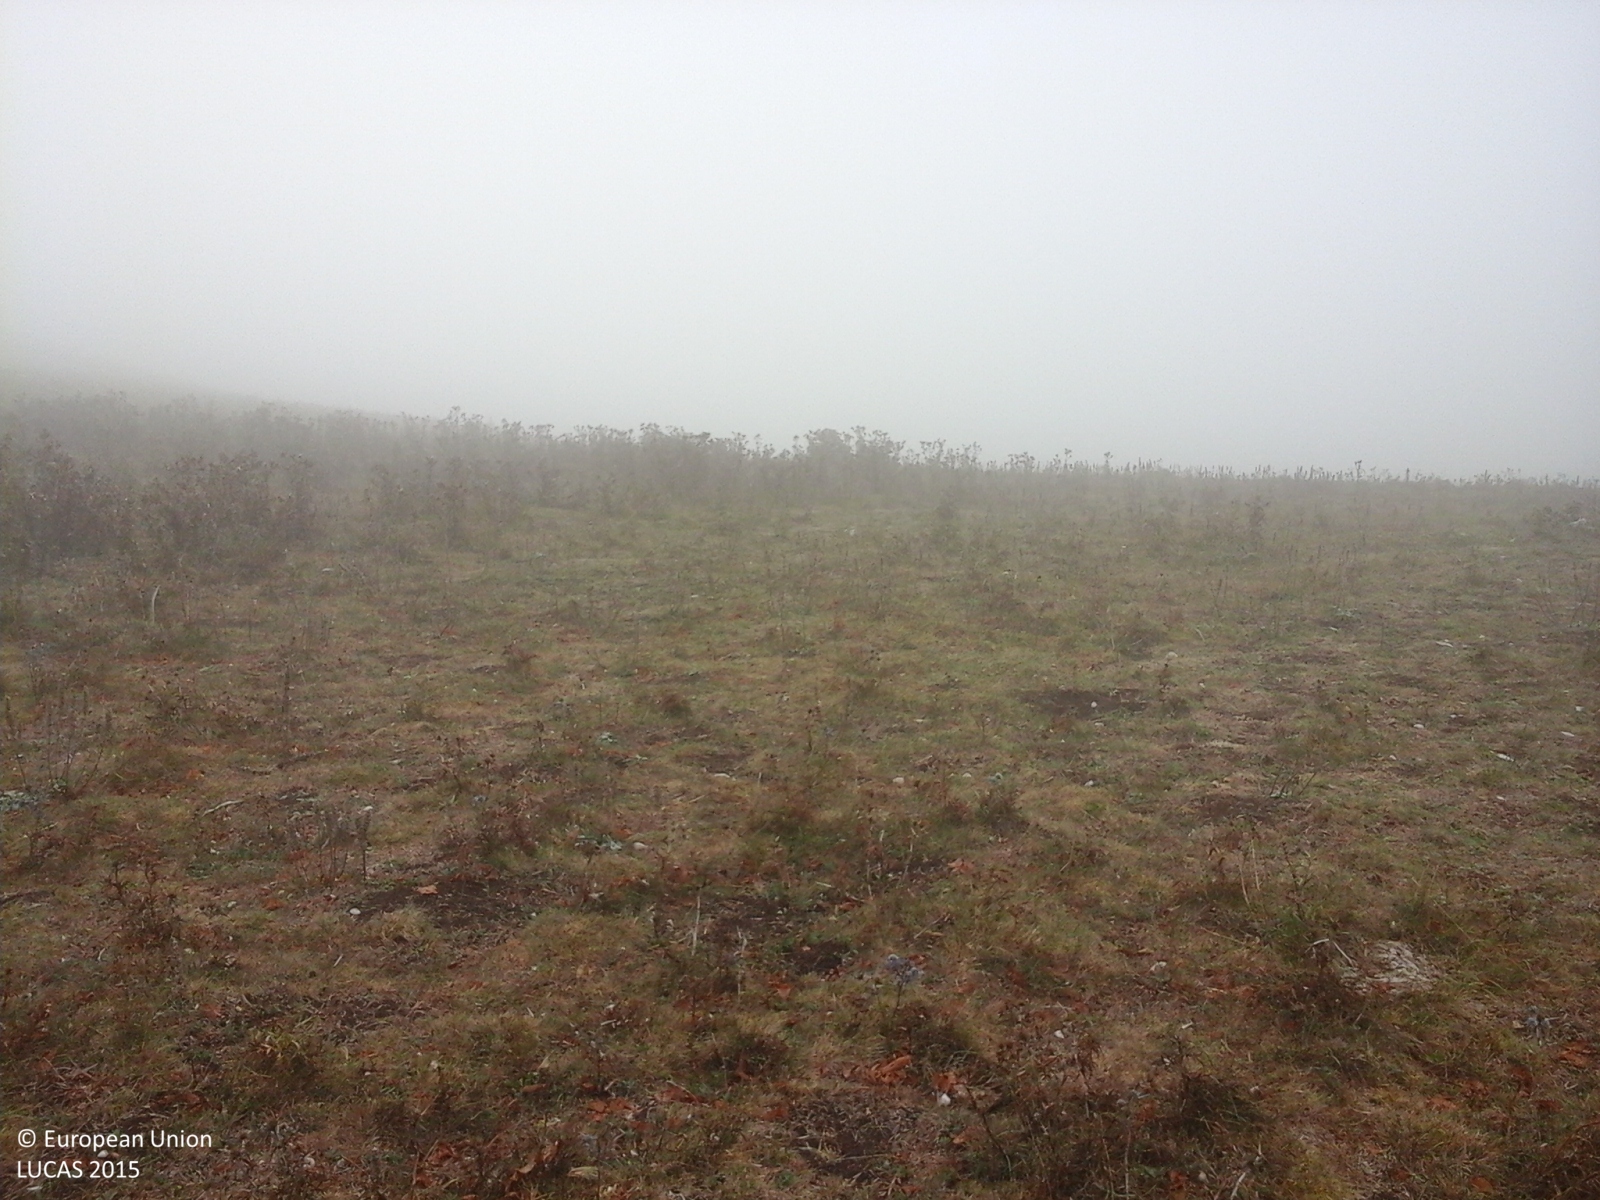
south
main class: Woodland
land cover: Broadleaved woodland
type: thermophilous deciduous forest
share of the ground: > 75 %
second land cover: Grassland without tree/shrub cover
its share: > 75 %
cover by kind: broadleaved forest trees 100 %
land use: Forestry
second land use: Agriculture (excluding fallow land and kitchen gardens)
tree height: > 5 m
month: September
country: IT
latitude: 41.6413
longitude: 14.2709
